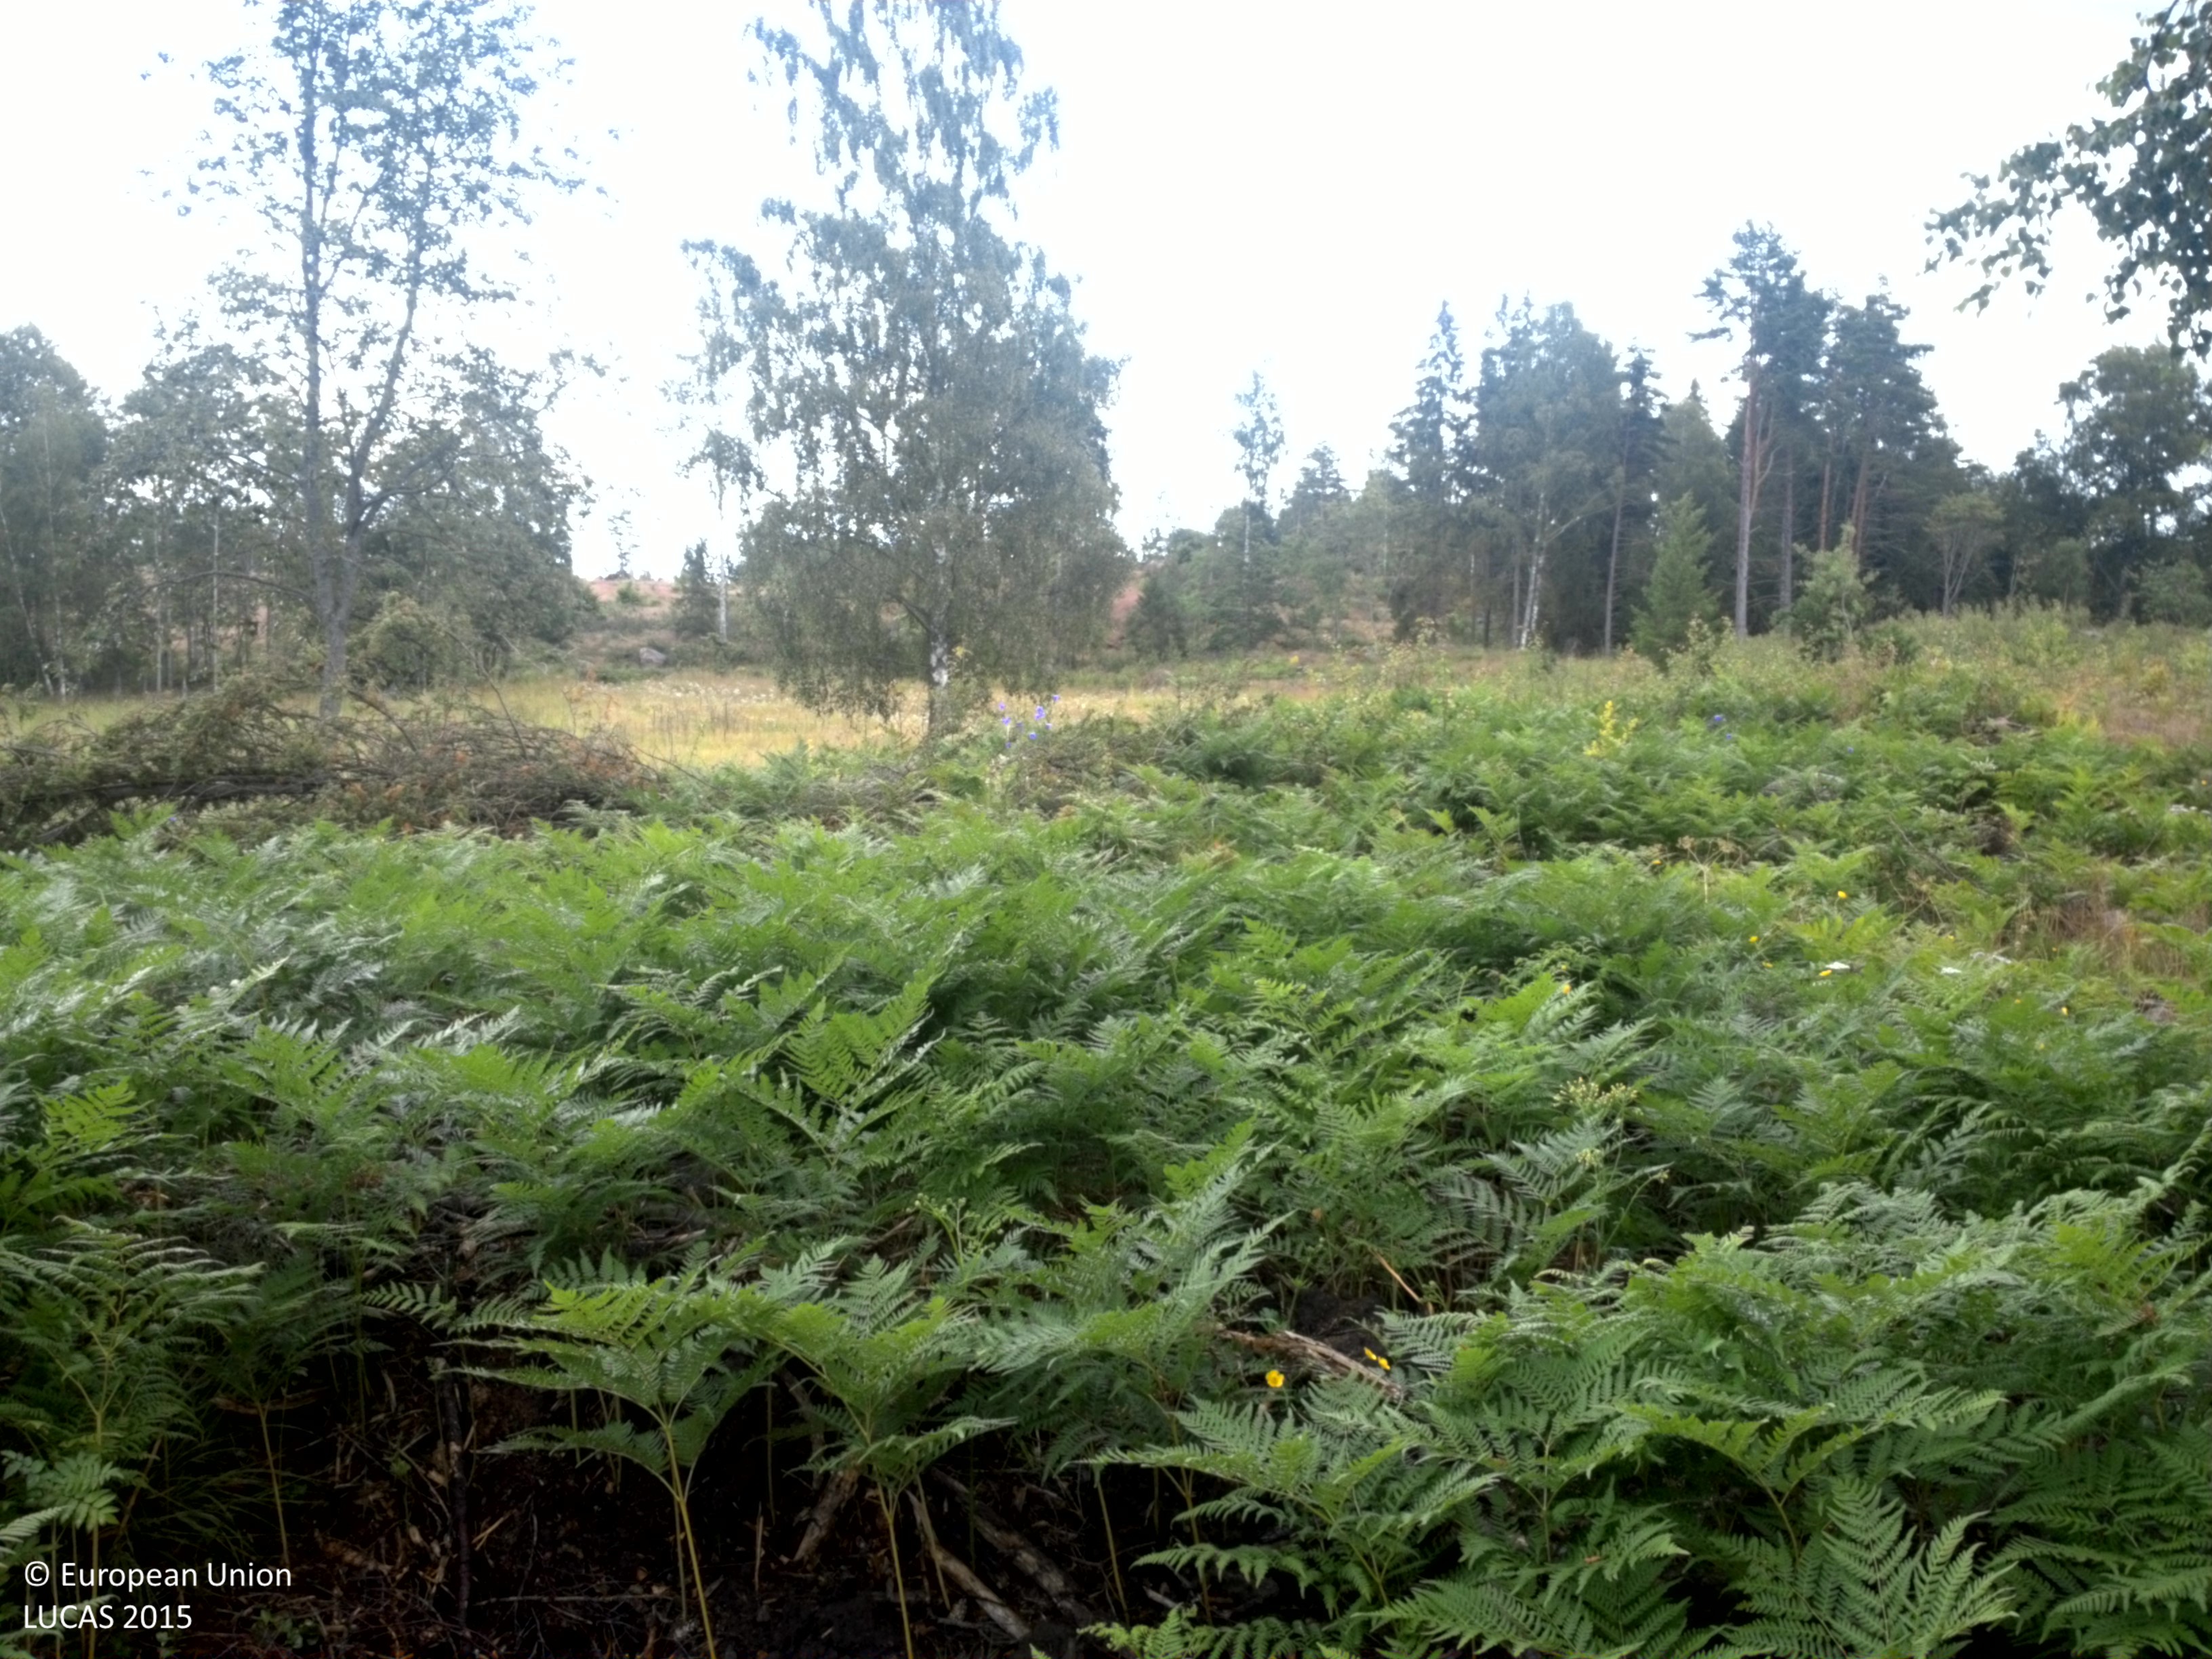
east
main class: Woodland
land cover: Broadleaved woodland
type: hemiboreal forest and nemoral coniferous forest and mixed broadleaved-coniferous forest
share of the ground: 10 - 25 %
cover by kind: herbaceous plants 85 %, broadleaved forest trees 15 %
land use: Forestry
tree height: < 5 m
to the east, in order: Broadleaved woodland; Fences; Grassland without tree/shrub cover; Tracks; Grassland without tree/shrub cover; Fences; Broadleaved woodland; Fences; Broadleaved woodland; Spruce dominated mixed woodland
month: July
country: SE
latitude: 59.9042
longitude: 18.5263
